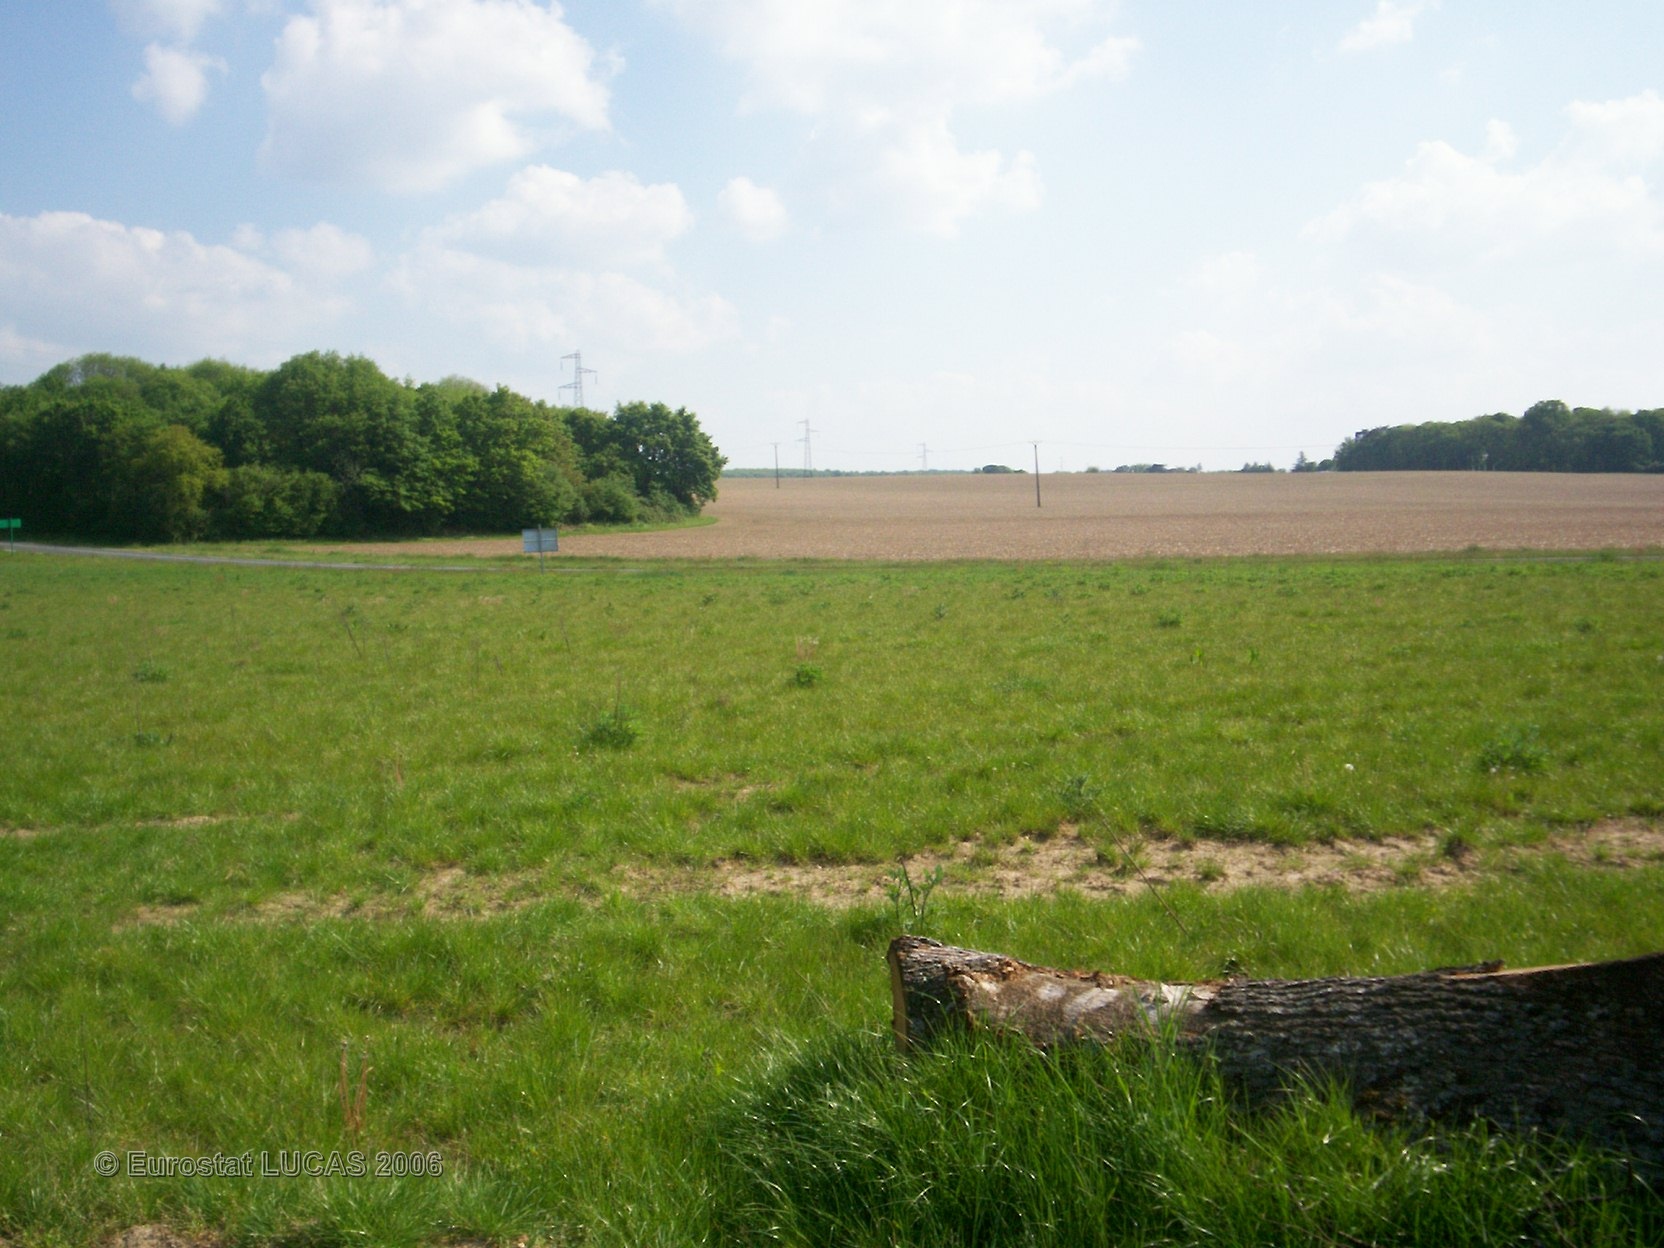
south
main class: Grassland
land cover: Grassland without tree/shrub cover
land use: Agriculture (excluding fallow land and kitchen gardens)
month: May
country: FR
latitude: 47.6224
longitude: 0.1954
